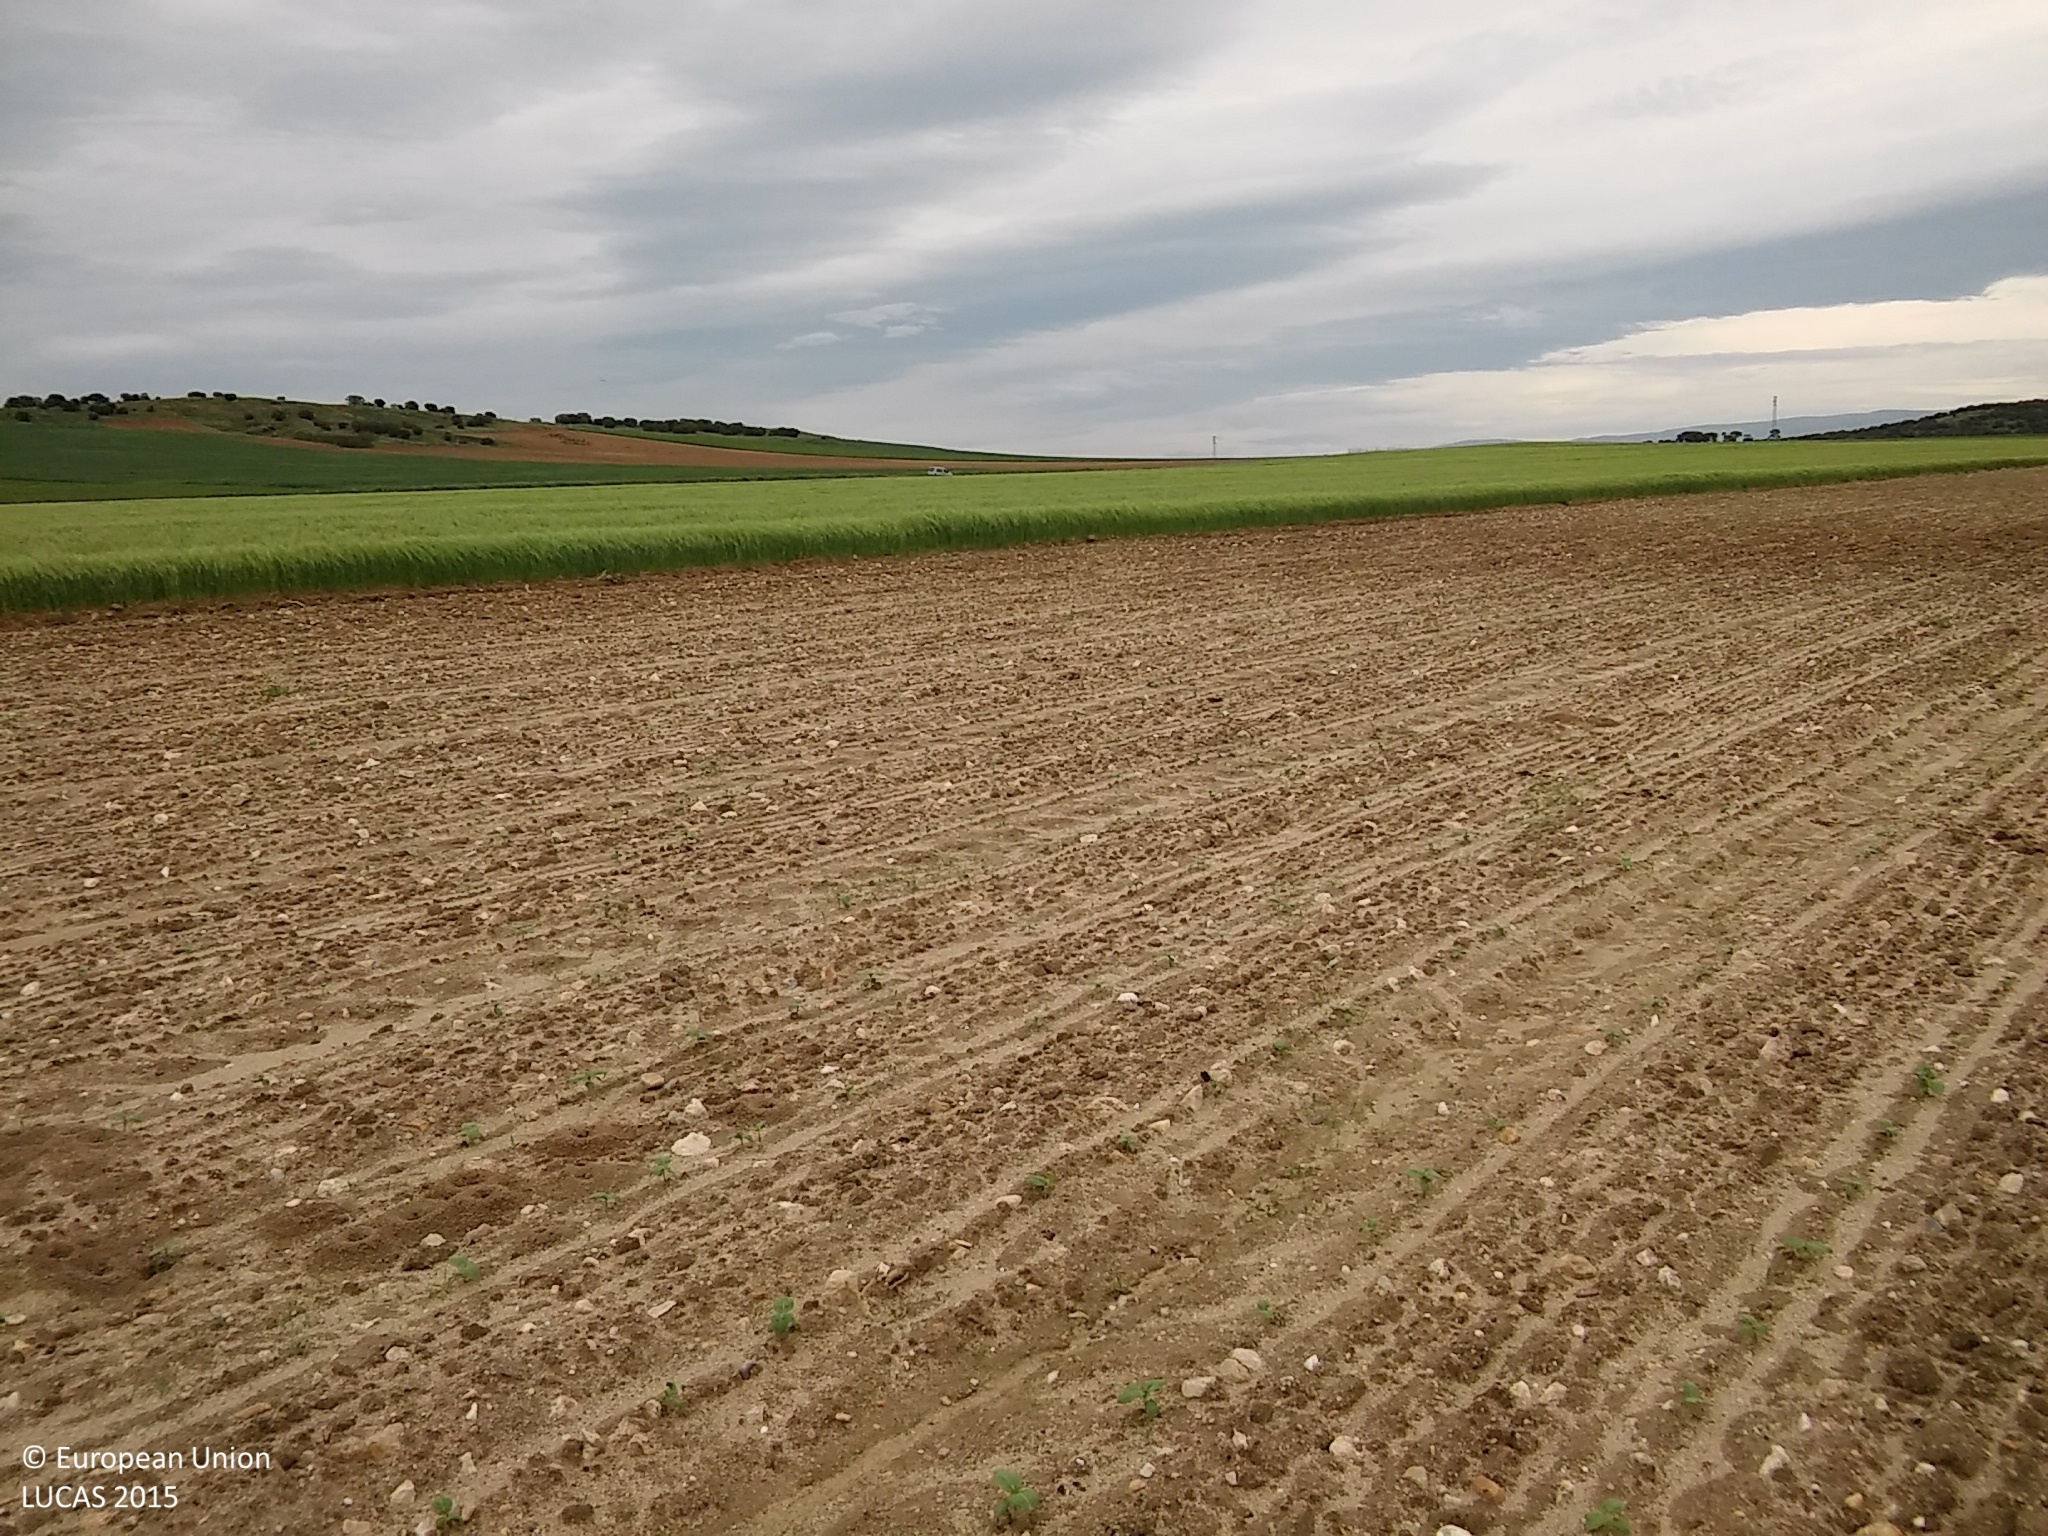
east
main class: Cropland
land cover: Sunflower
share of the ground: < 10 %
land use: Agriculture (excluding fallow land and kitchen gardens)
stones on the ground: 25 - 50 %
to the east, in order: Sunflower; Barley
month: May
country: ES
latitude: 41.1493
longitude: -4.1008
